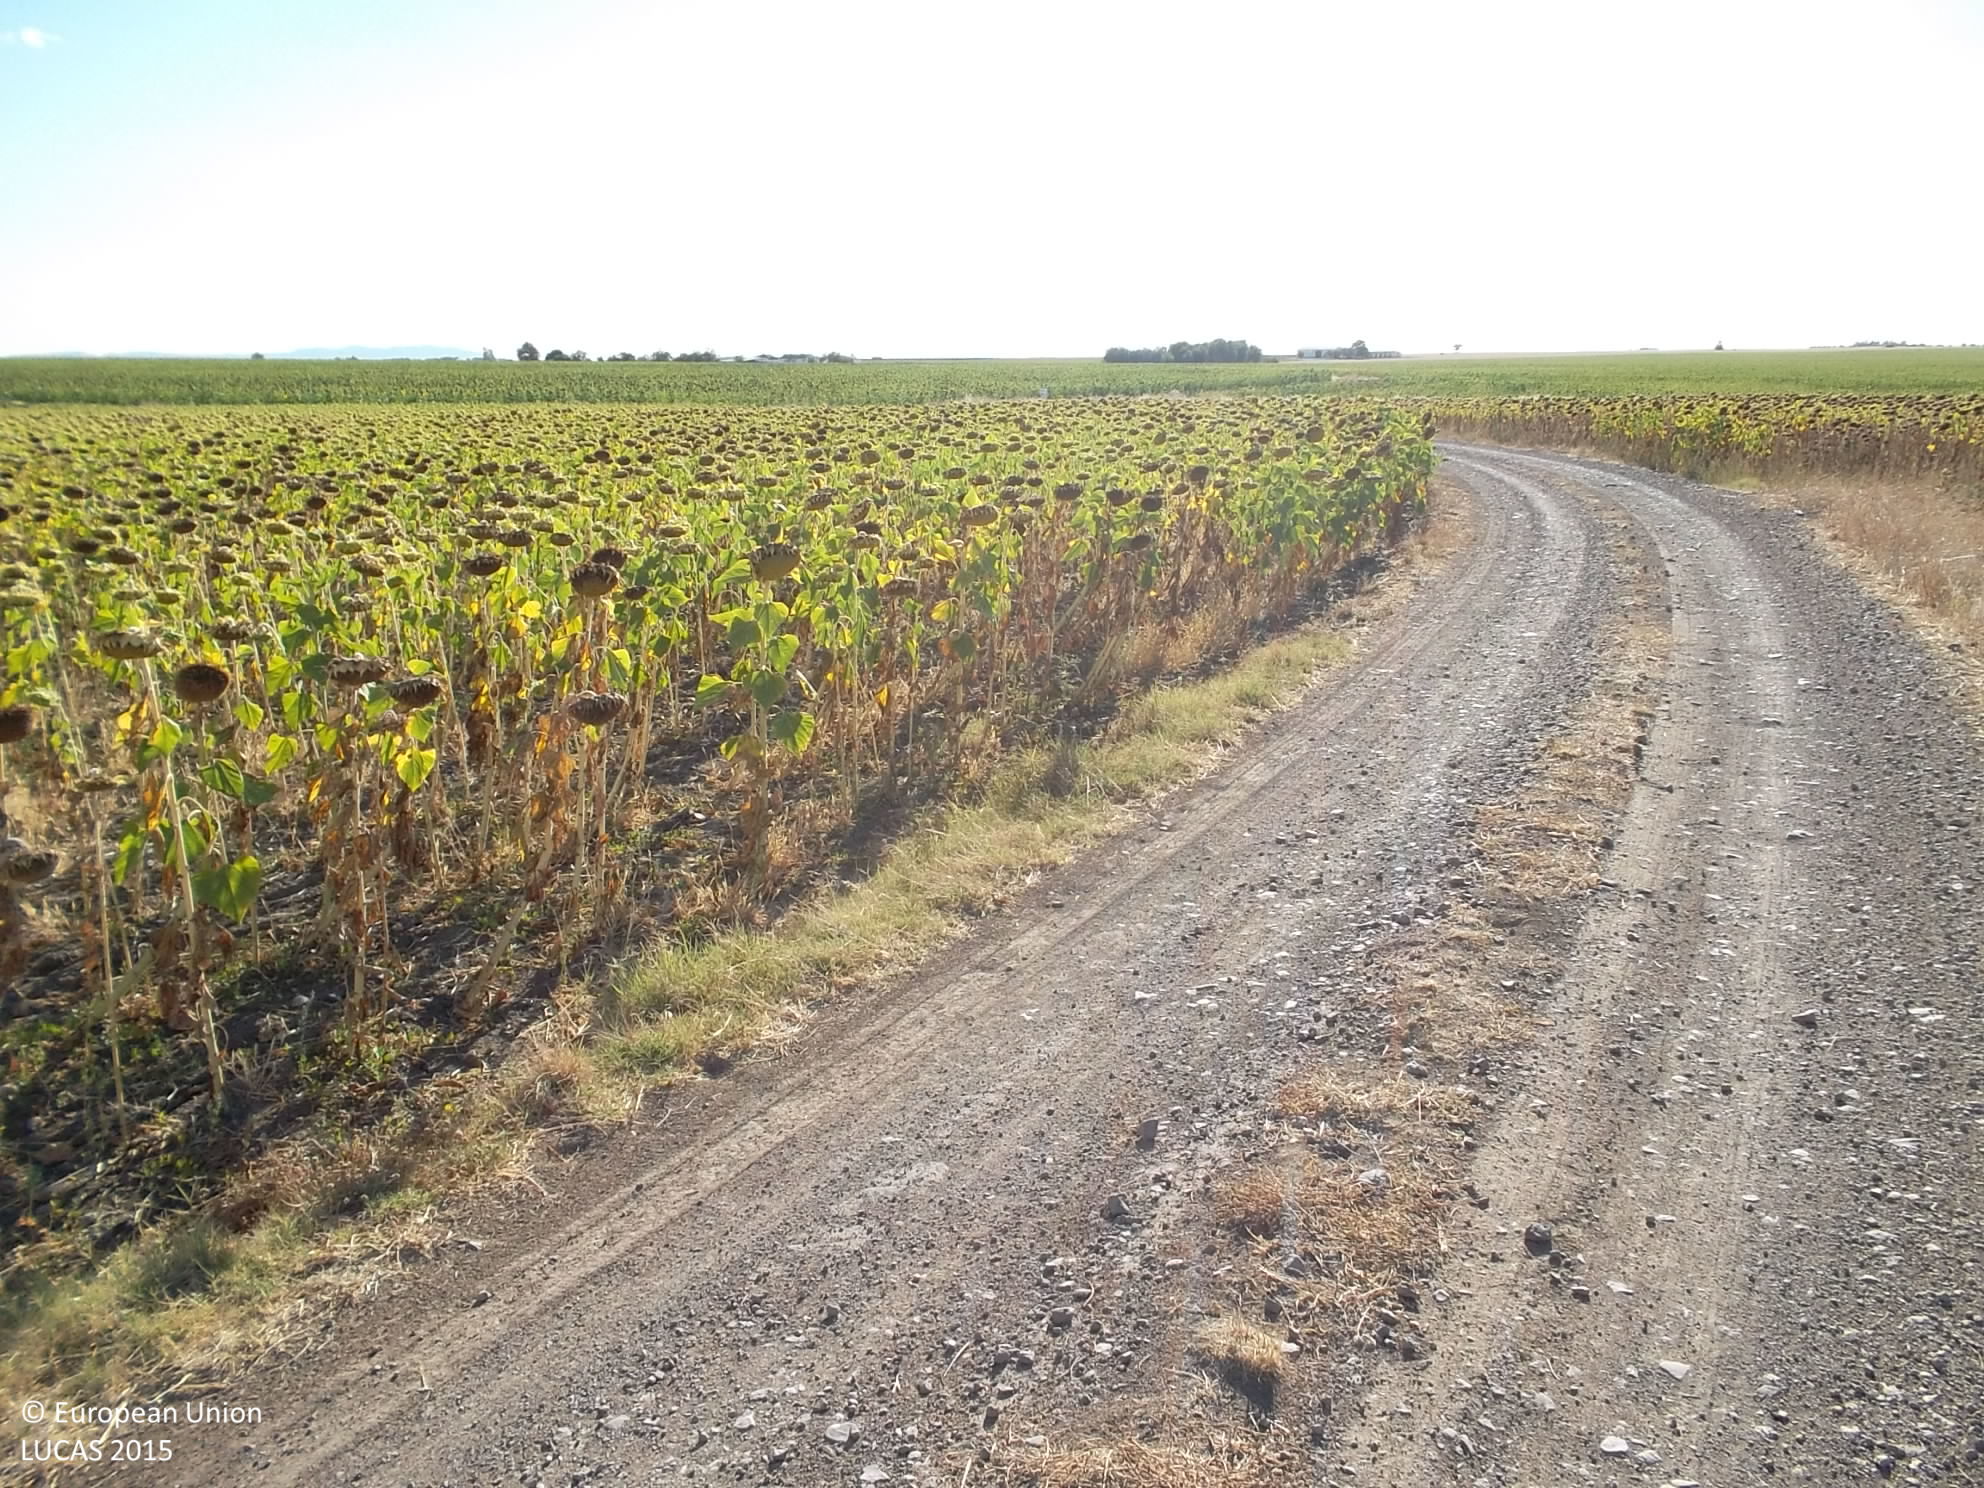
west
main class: Artificial land
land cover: Non built-up linear features
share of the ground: > 75 %
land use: Road transport
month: July
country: ES
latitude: 38.3111
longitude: -5.7152
